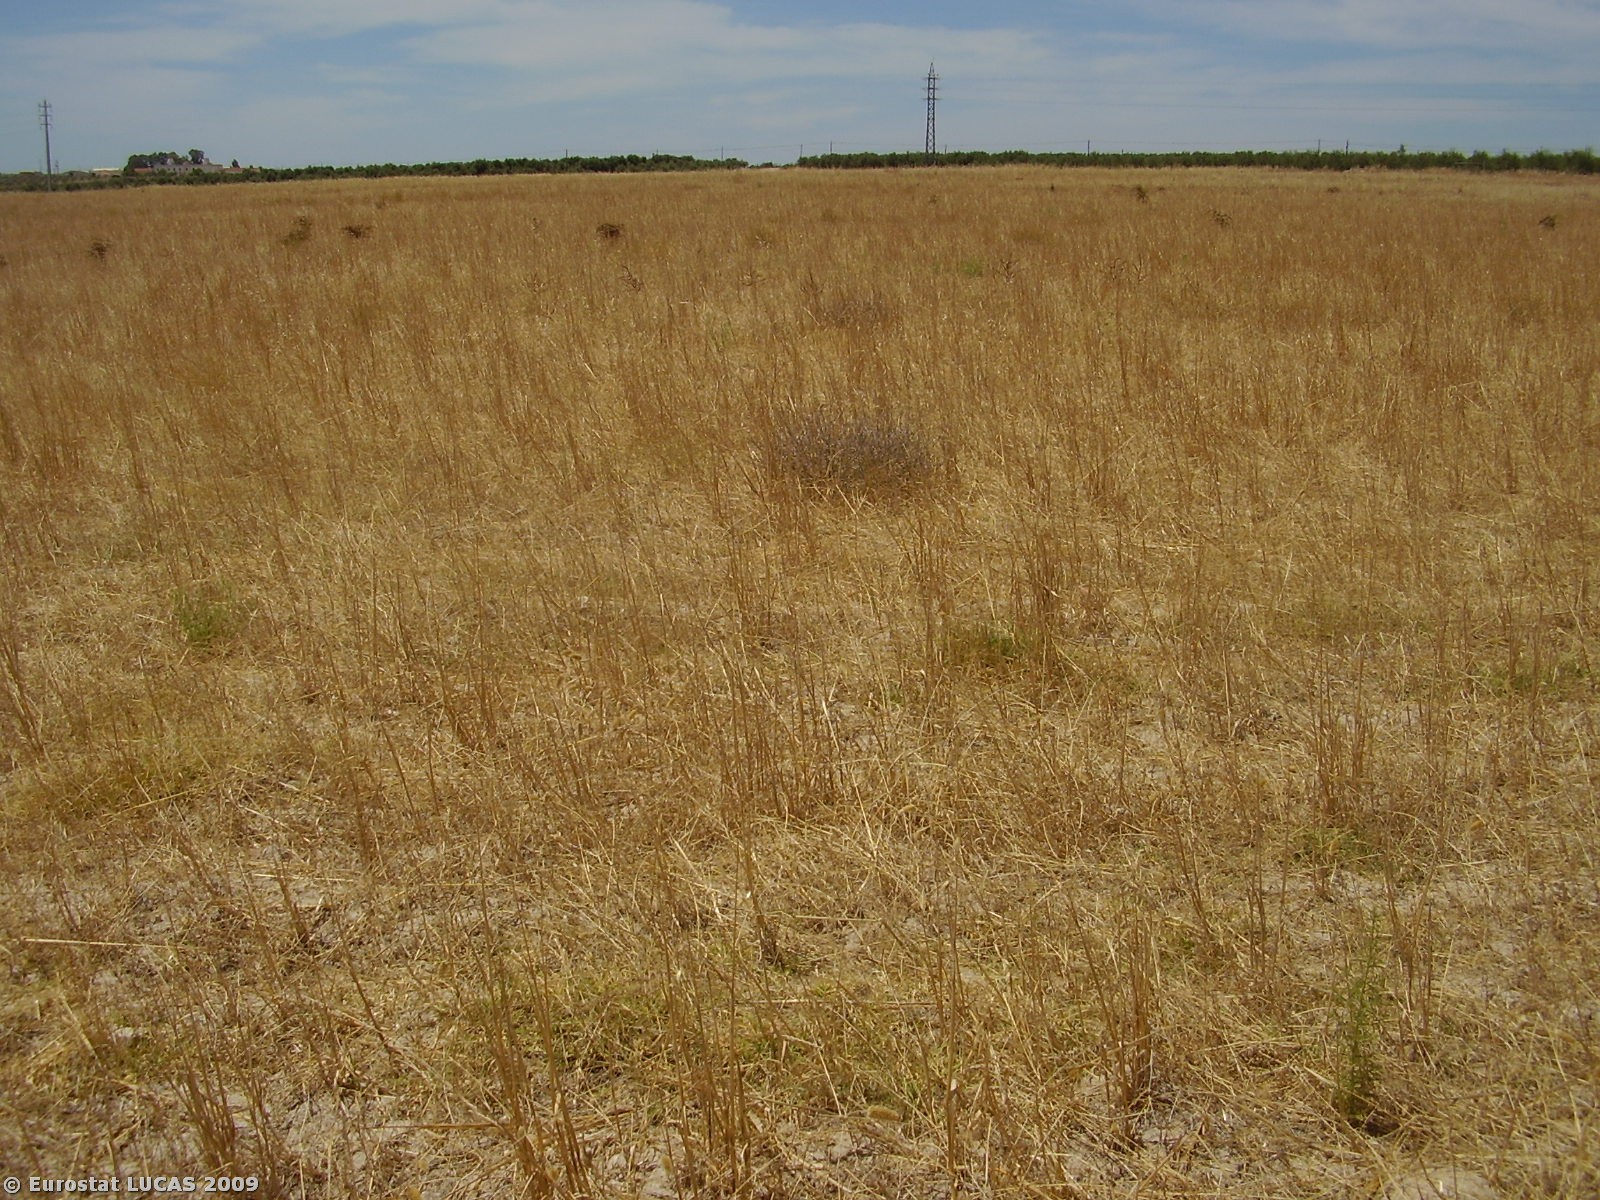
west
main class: Cropland
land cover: Oats
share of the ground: > 75 %
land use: Agriculture (excluding fallow land and kitchen gardens)
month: August
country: PT
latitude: 38.0973
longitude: -7.8520
